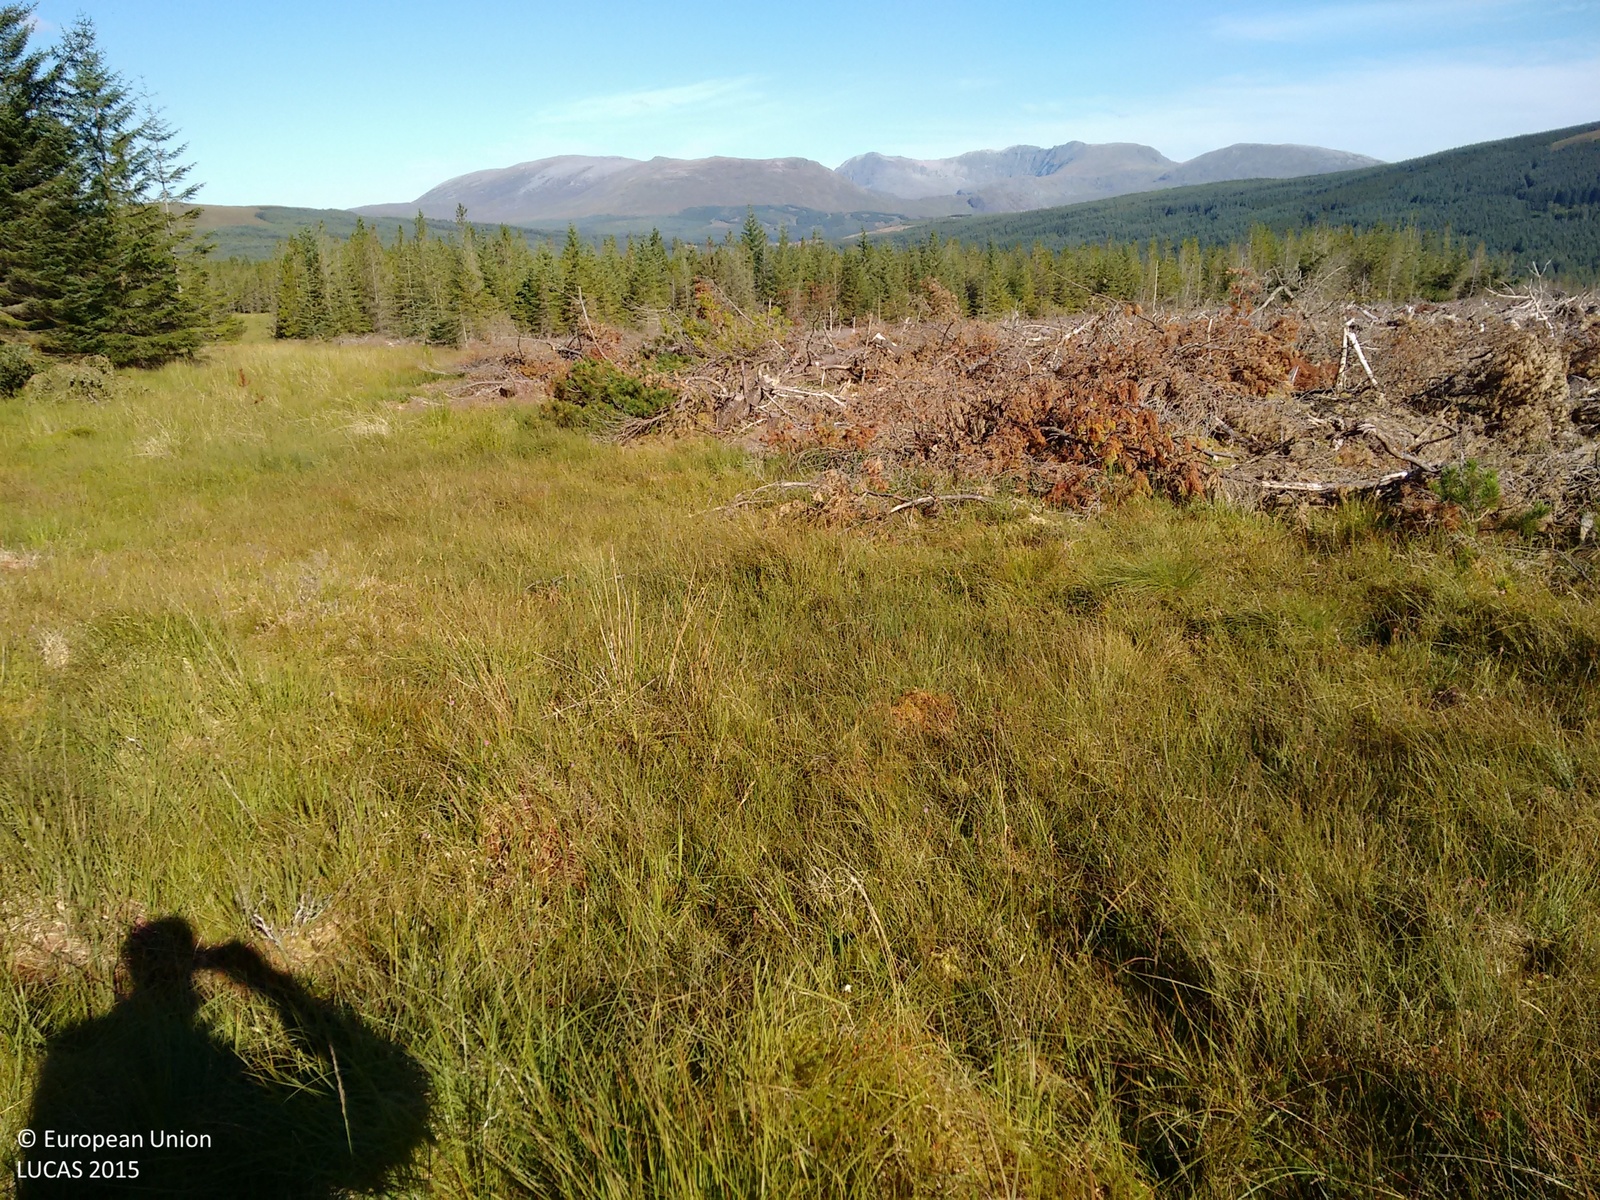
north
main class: Grassland
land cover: Grassland without tree/shrub cover
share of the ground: > 75 %
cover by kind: herbaceous plants 90 %, lichens and mosses 10 %
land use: Forestry
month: September
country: GB
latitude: 58.0127
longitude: -4.8377
